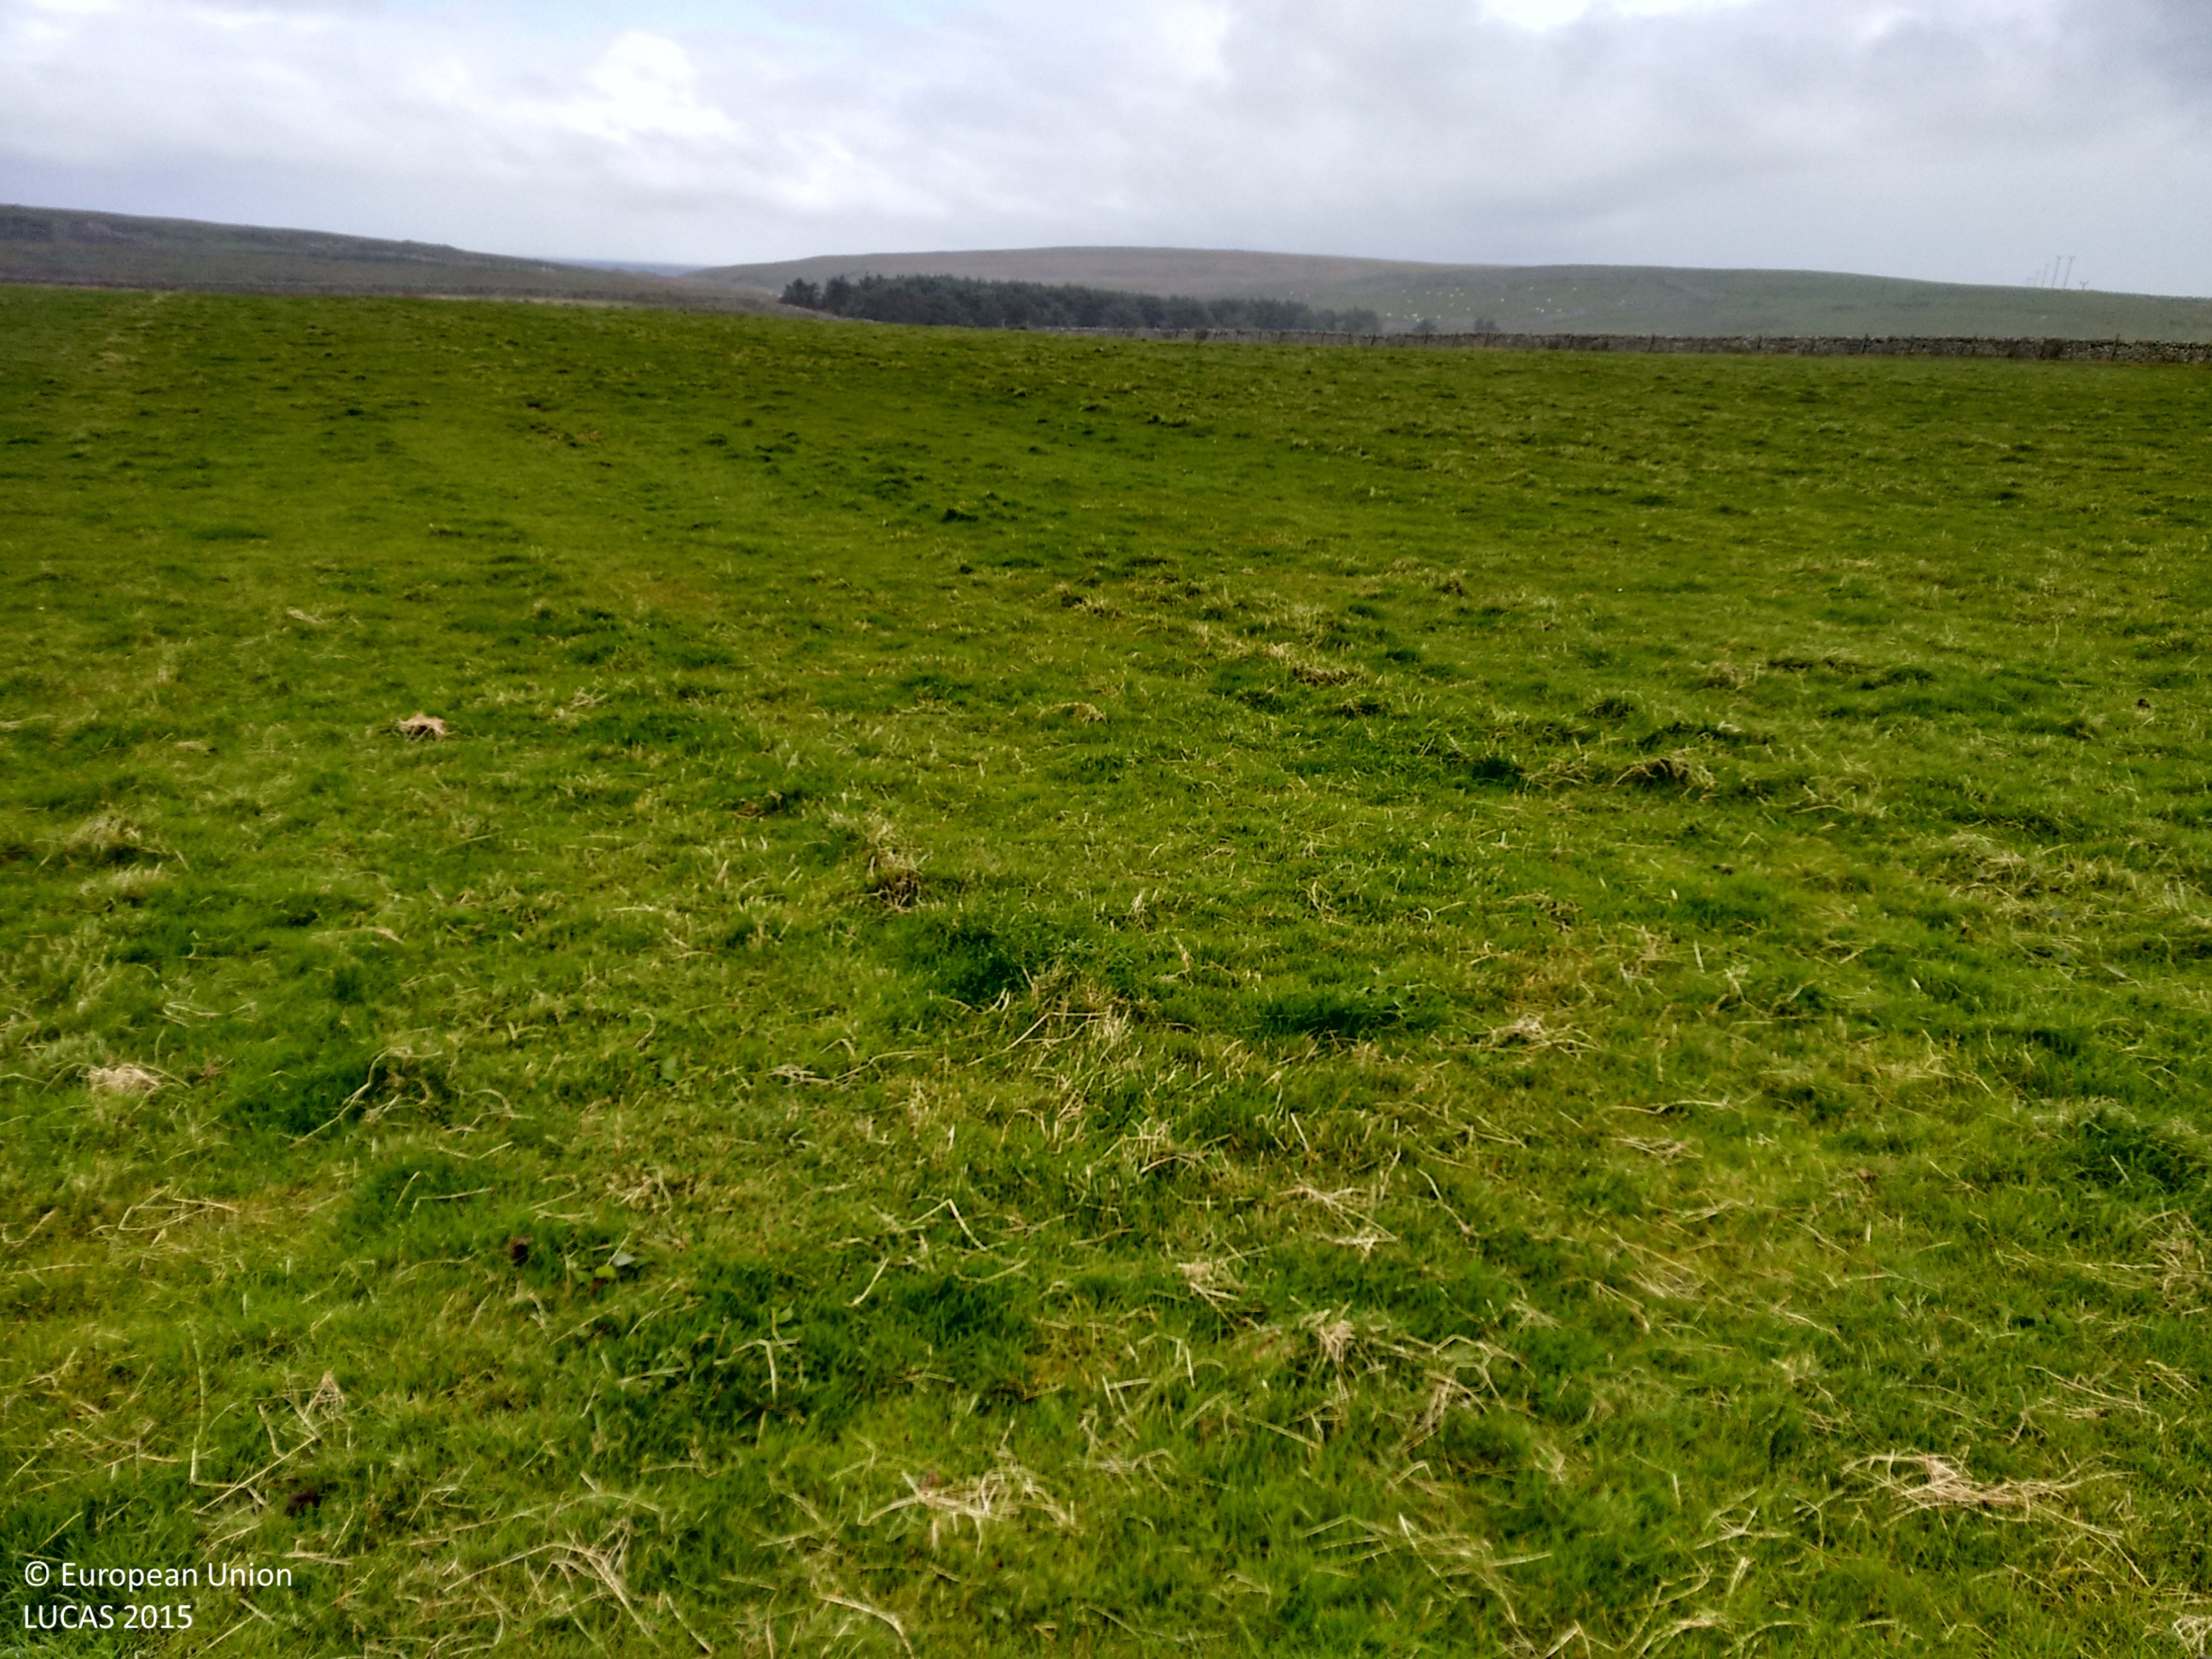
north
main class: Grassland
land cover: Grassland without tree/shrub cover
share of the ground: > 75 %
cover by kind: herbaceous plants 100 %
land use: Agriculture (excluding fallow land and kitchen gardens)
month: September
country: GB
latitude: 58.5635
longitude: -3.8051
